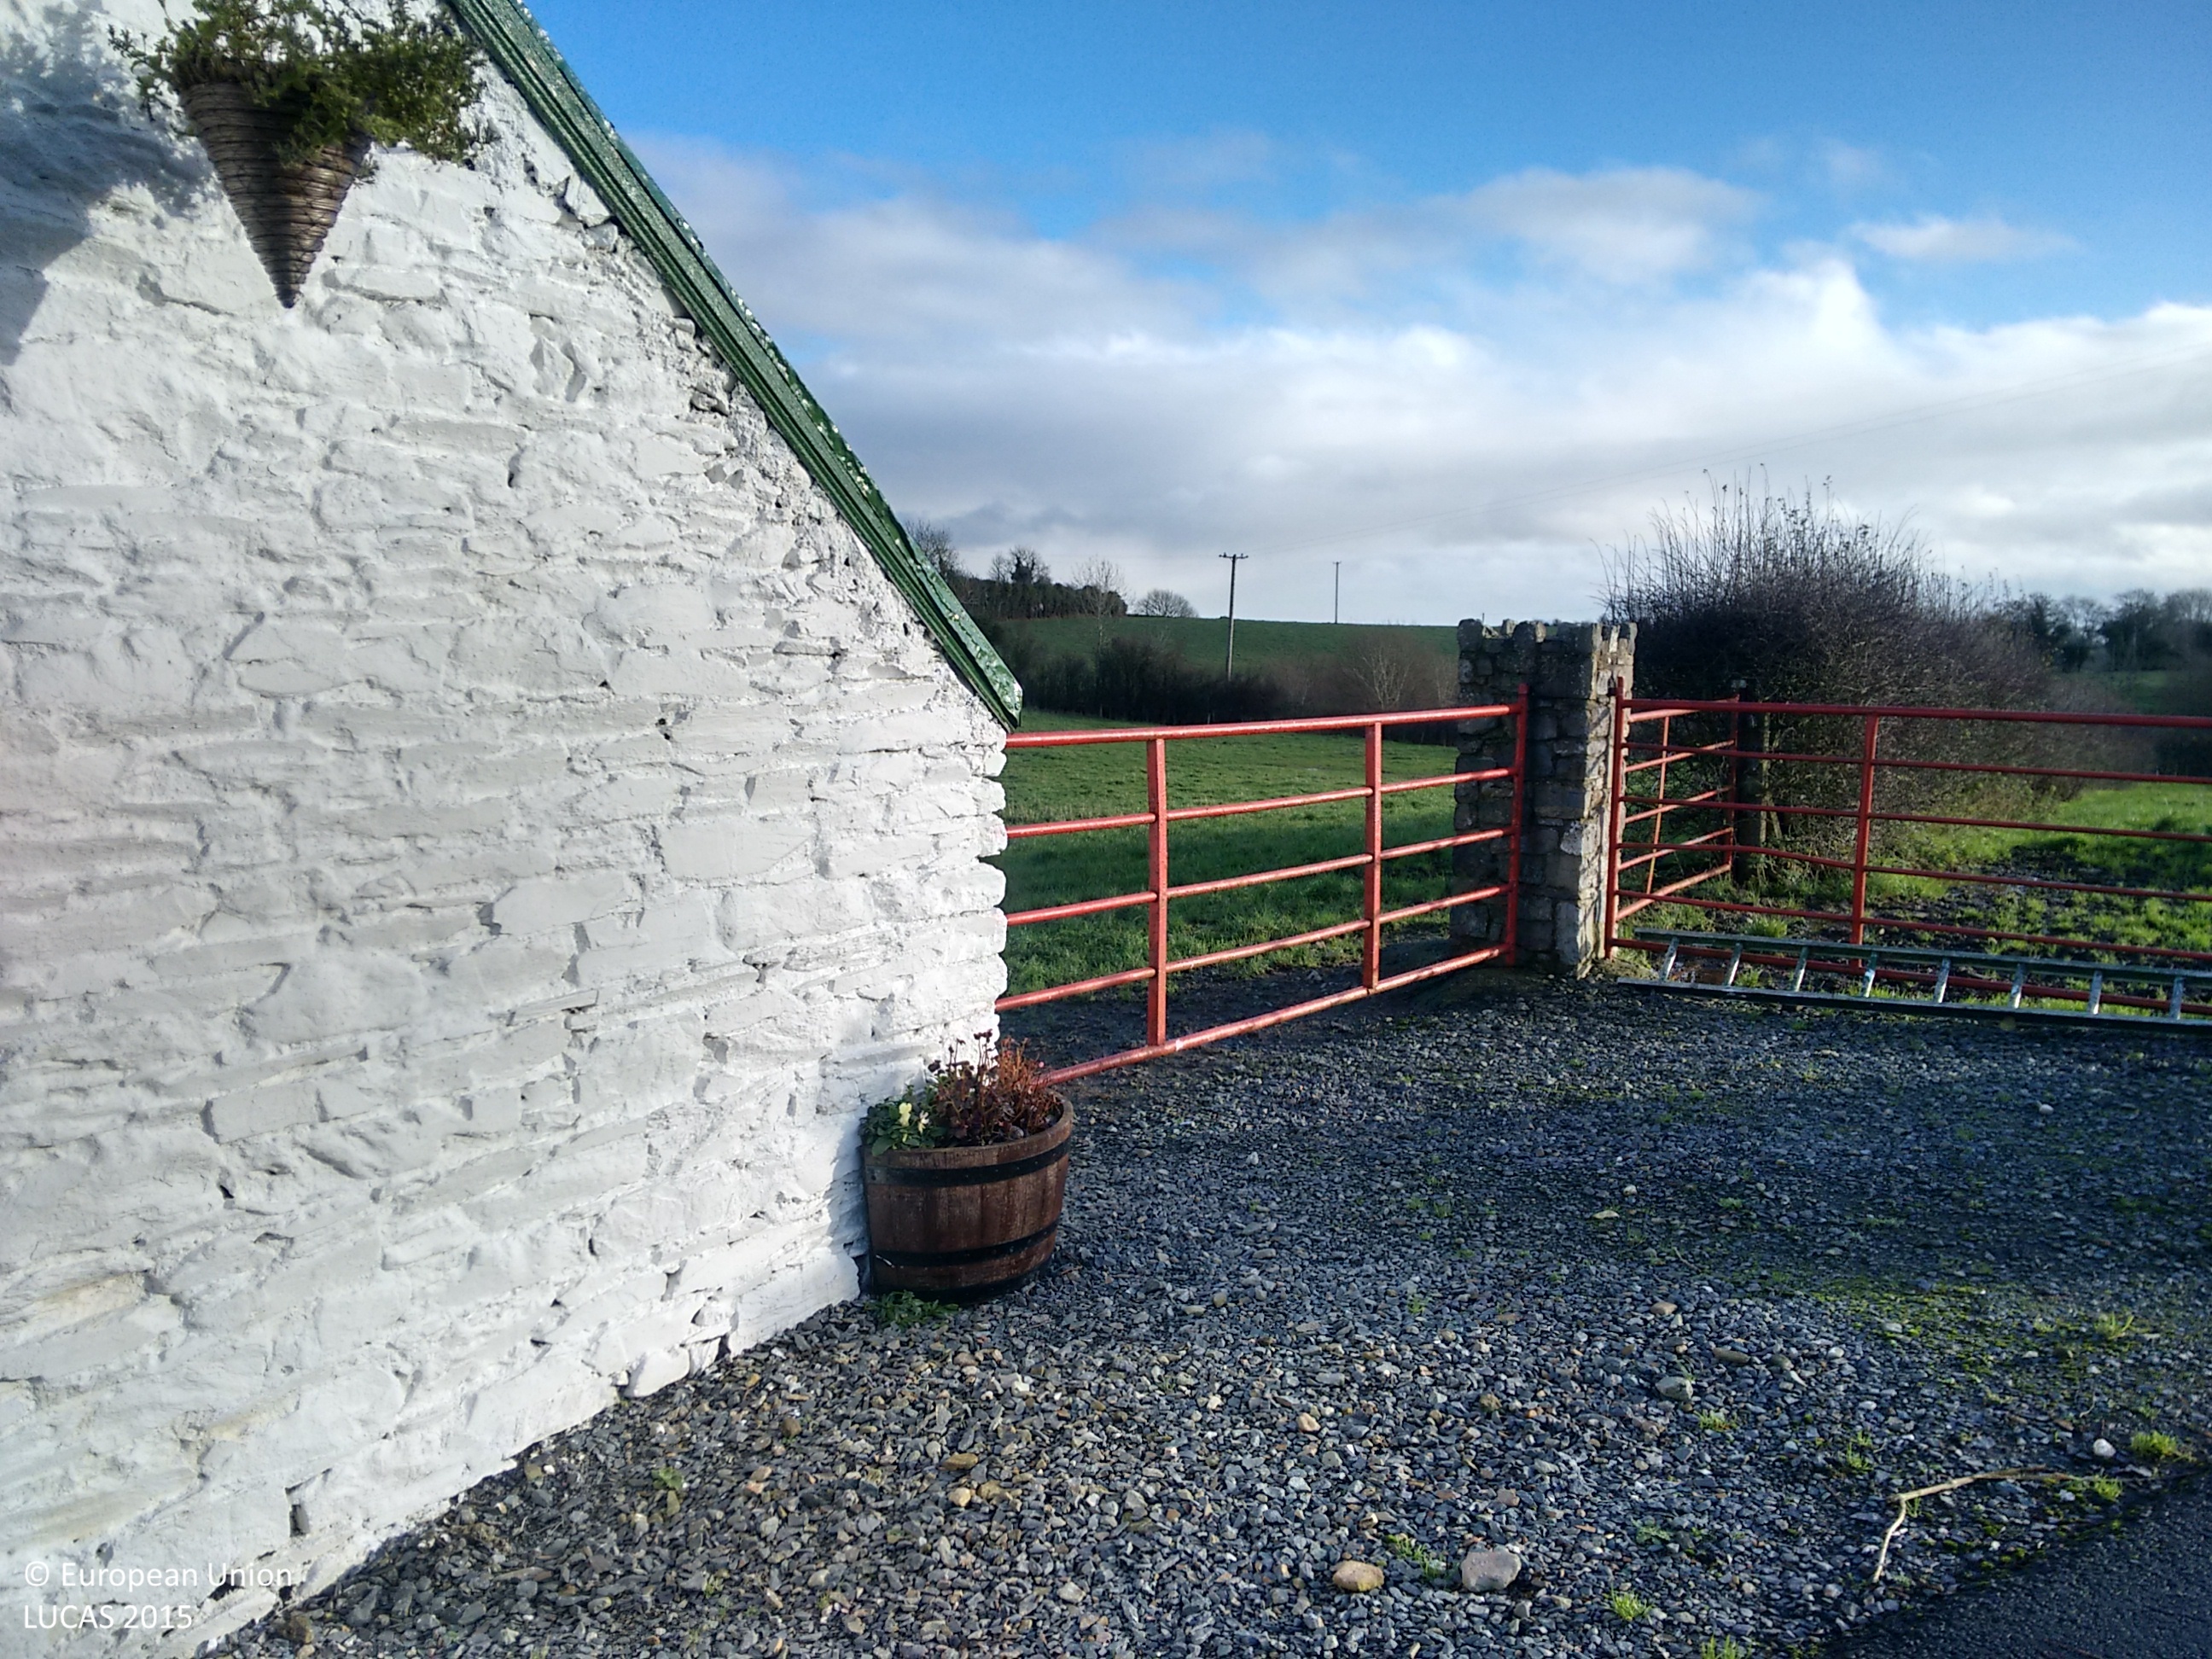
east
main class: Grassland
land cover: Grassland without tree/shrub cover
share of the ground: > 75 %
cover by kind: herbaceous plants 100 %
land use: Agriculture (excluding fallow land and kitchen gardens)
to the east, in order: Grassland without tree/shrub cover; Fences; Grassland without tree/shrub cover; Fences; Grassland without tree/shrub cover; Broadleaved woodland; Grassland without tree/shrub cover
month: December
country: IE
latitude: 53.9425
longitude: -6.8173
